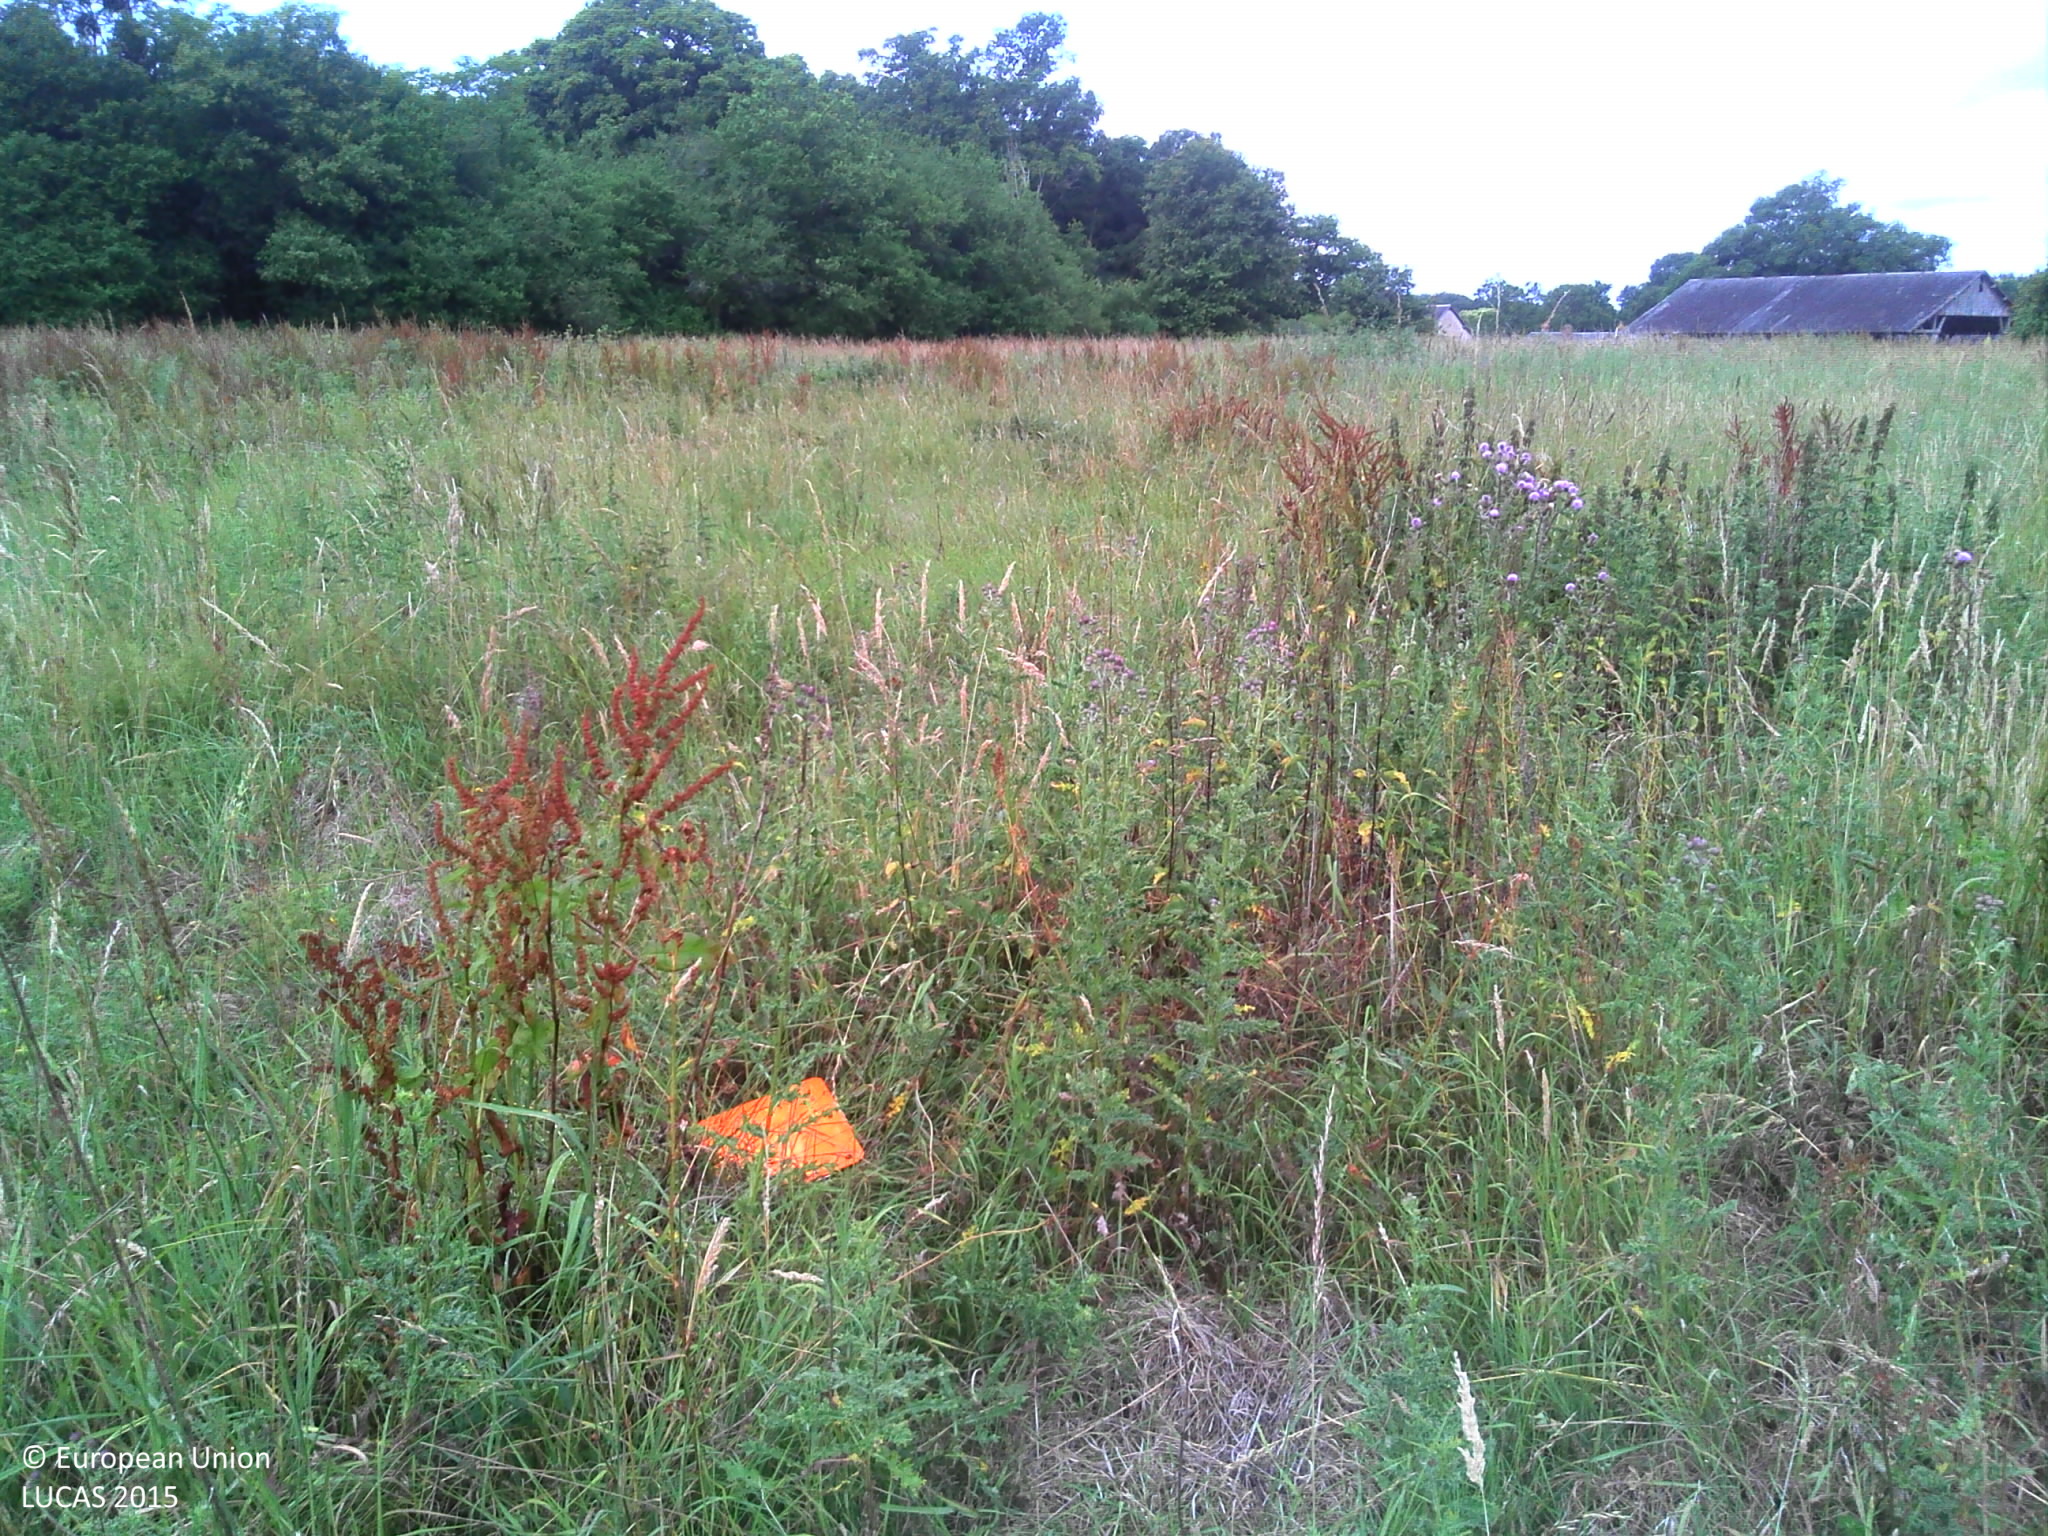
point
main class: Grassland
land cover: Grassland without tree/shrub cover
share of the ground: > 75 %
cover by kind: herbaceous plants 100 %
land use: Agriculture (excluding fallow land and kitchen gardens)
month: June
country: FR
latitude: 47.6442
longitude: 2.5238
